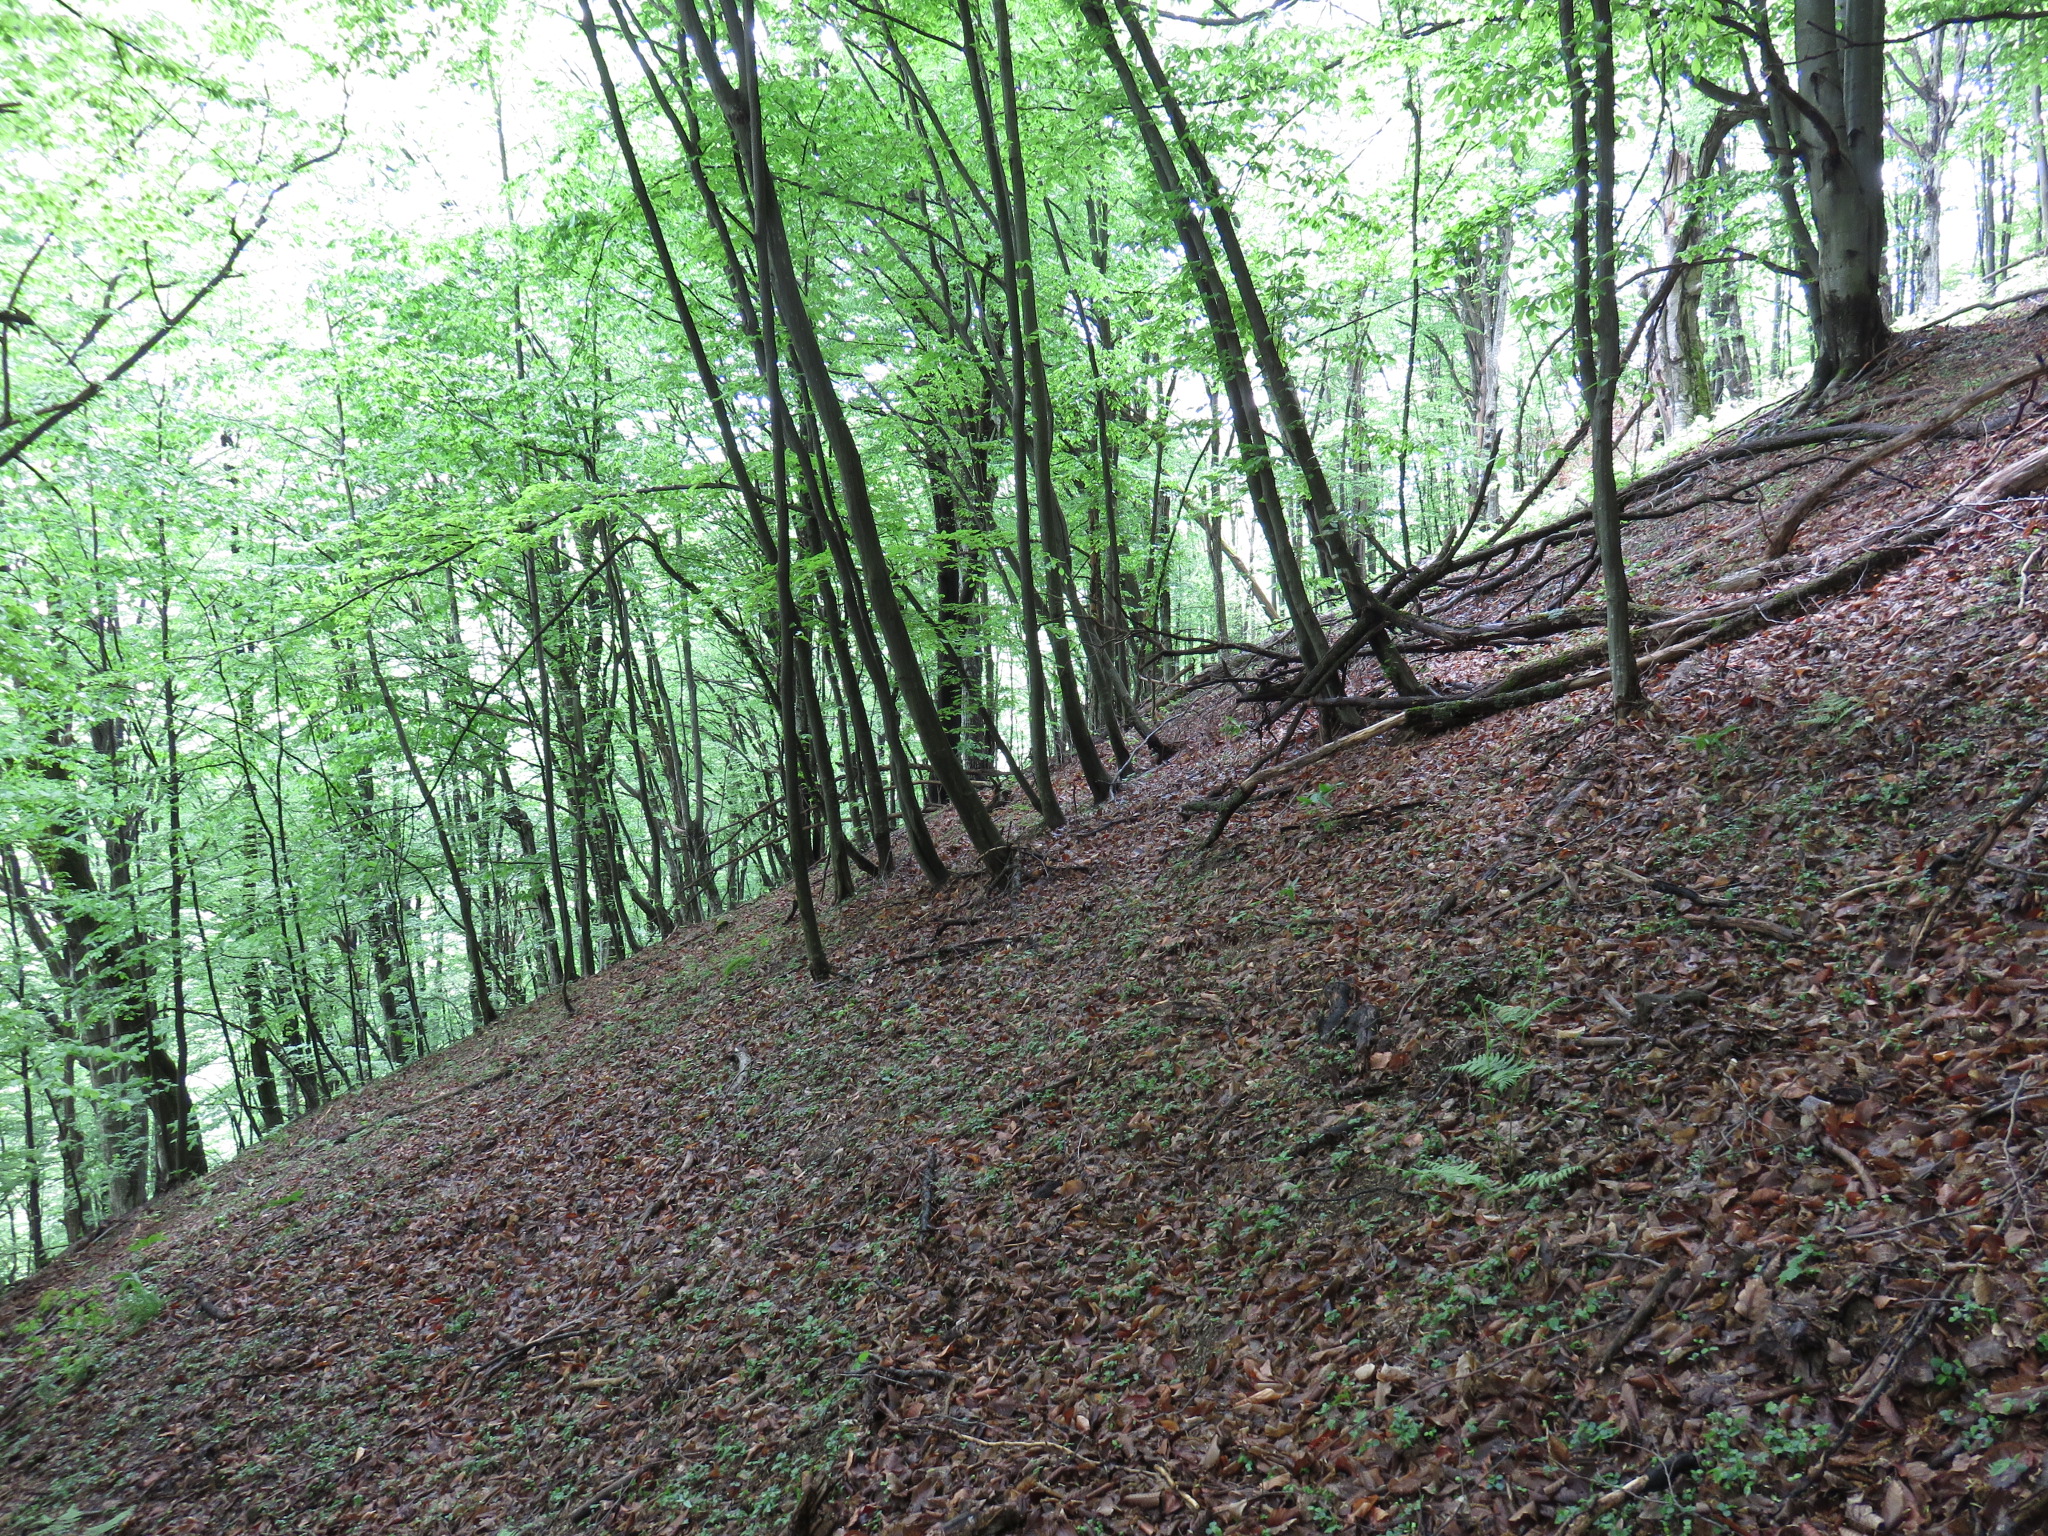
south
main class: Woodland
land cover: Broadleaved woodland
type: beech forest
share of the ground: > 75 %
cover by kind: broadleaved forest trees 80 %, unconsolidated bare surface 20 %
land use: Forestry
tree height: > 5 m
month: May
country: BG
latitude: 42.8068
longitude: 24.7951
